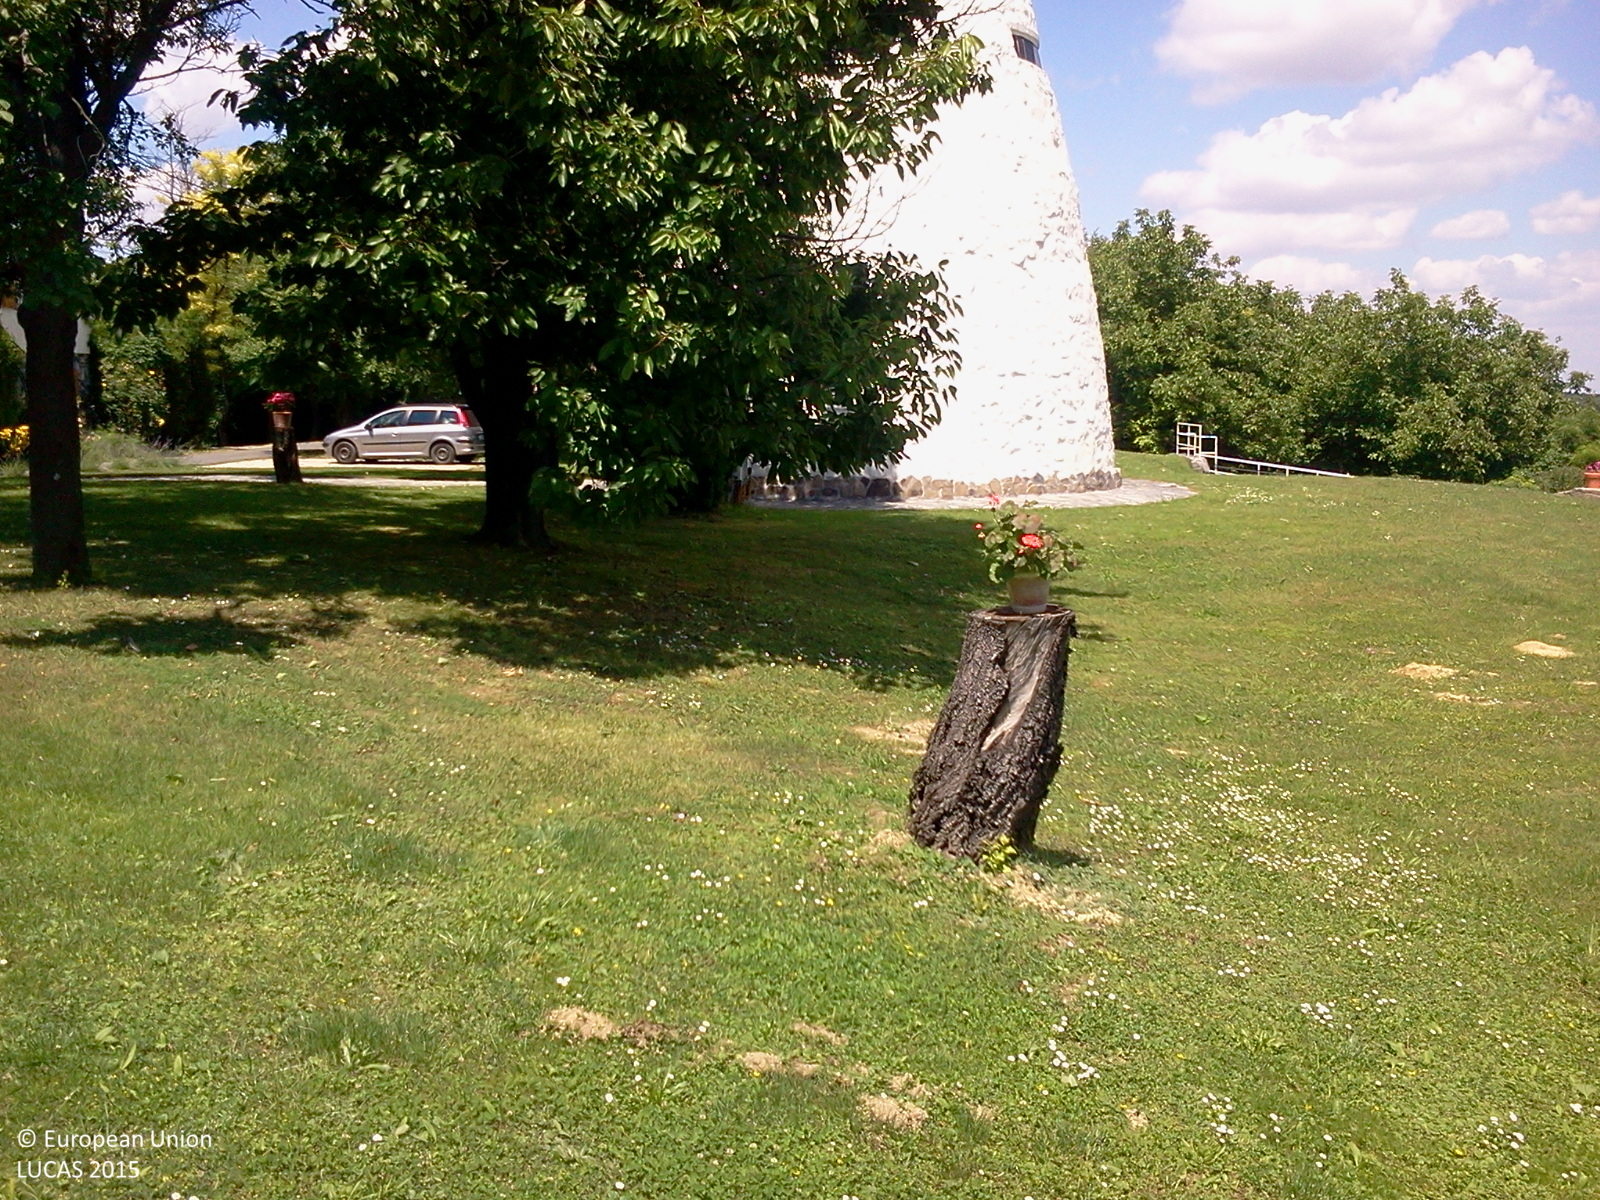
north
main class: Grassland
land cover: Grassland without tree/shrub cover
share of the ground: > 75 %
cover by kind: herbaceous plants 100 %
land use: Agriculture (excluding fallow land and kitchen gardens)
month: June
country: HU
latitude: 46.8903
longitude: 17.1311
